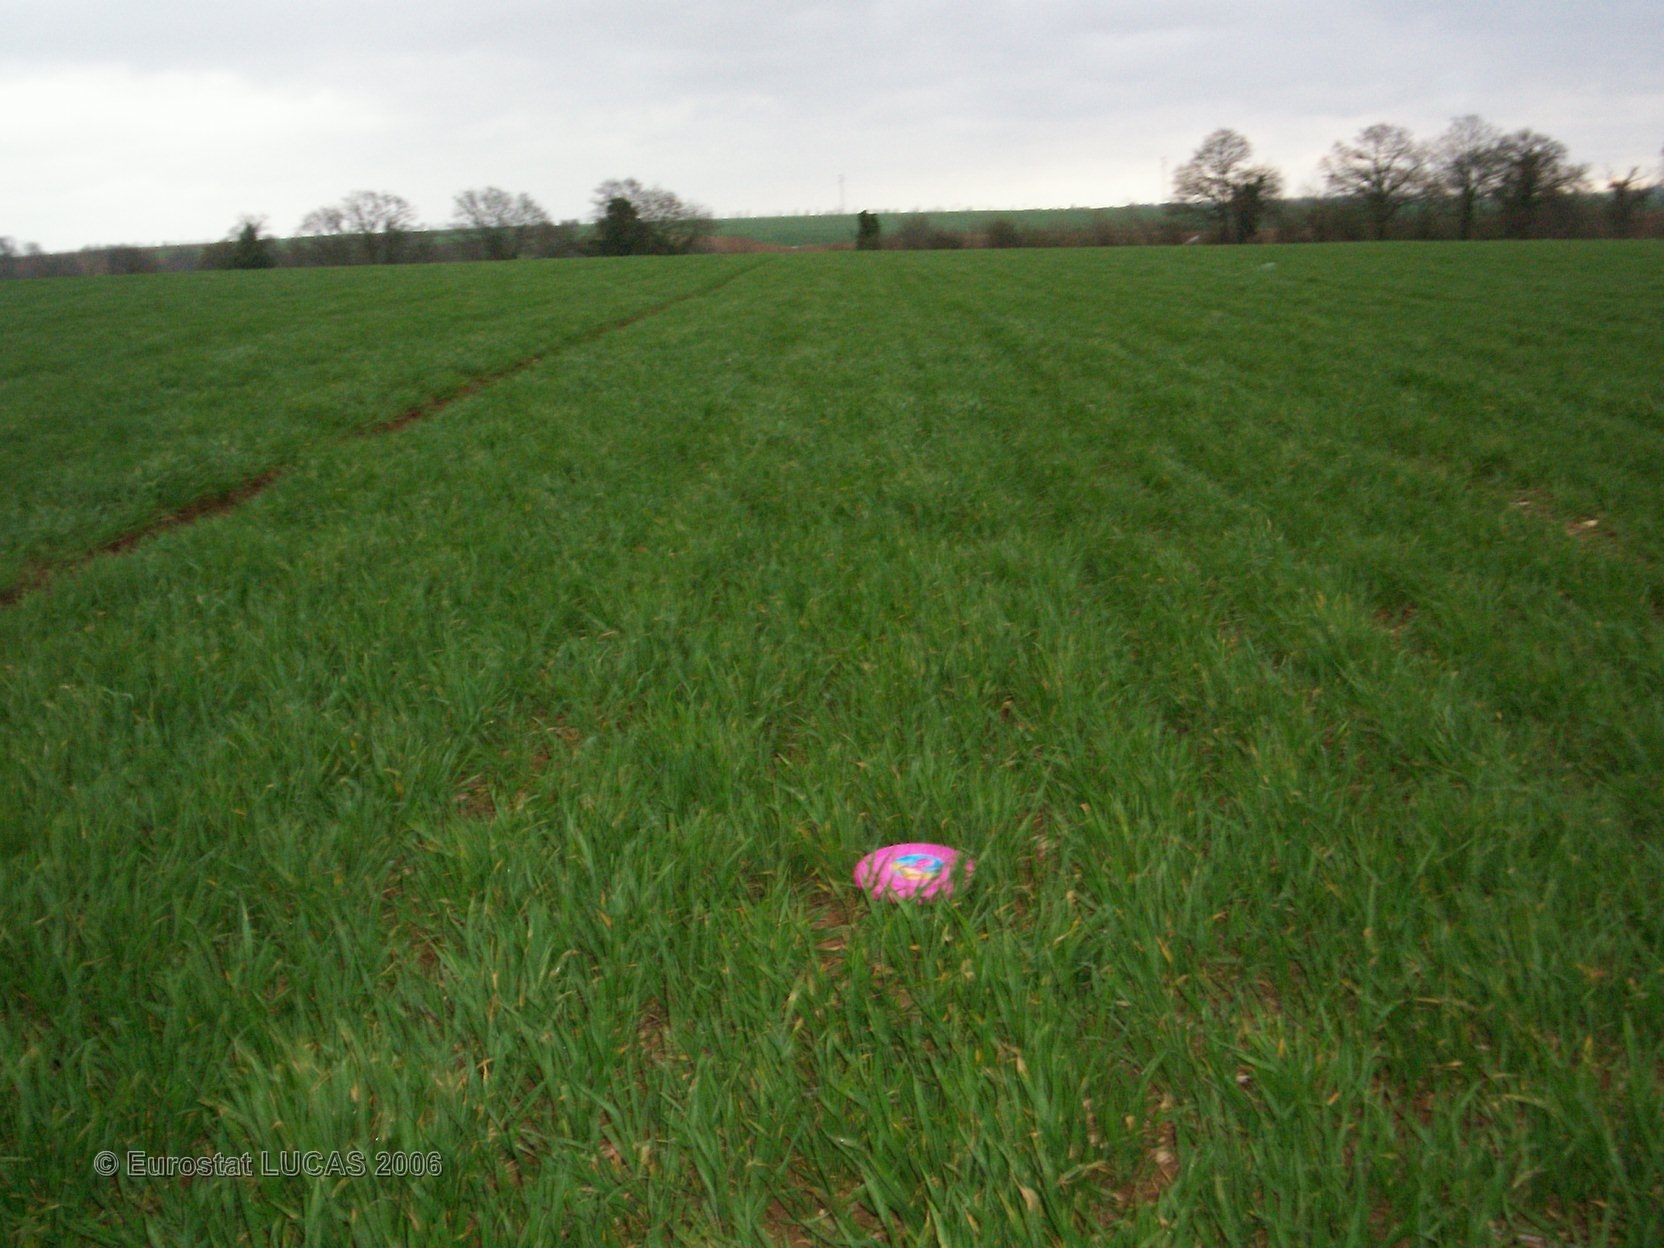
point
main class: Cropland
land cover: Common wheat
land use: Agriculture (excluding fallow land and kitchen gardens)
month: April
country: FR
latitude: 48.3587
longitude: 0.3241
